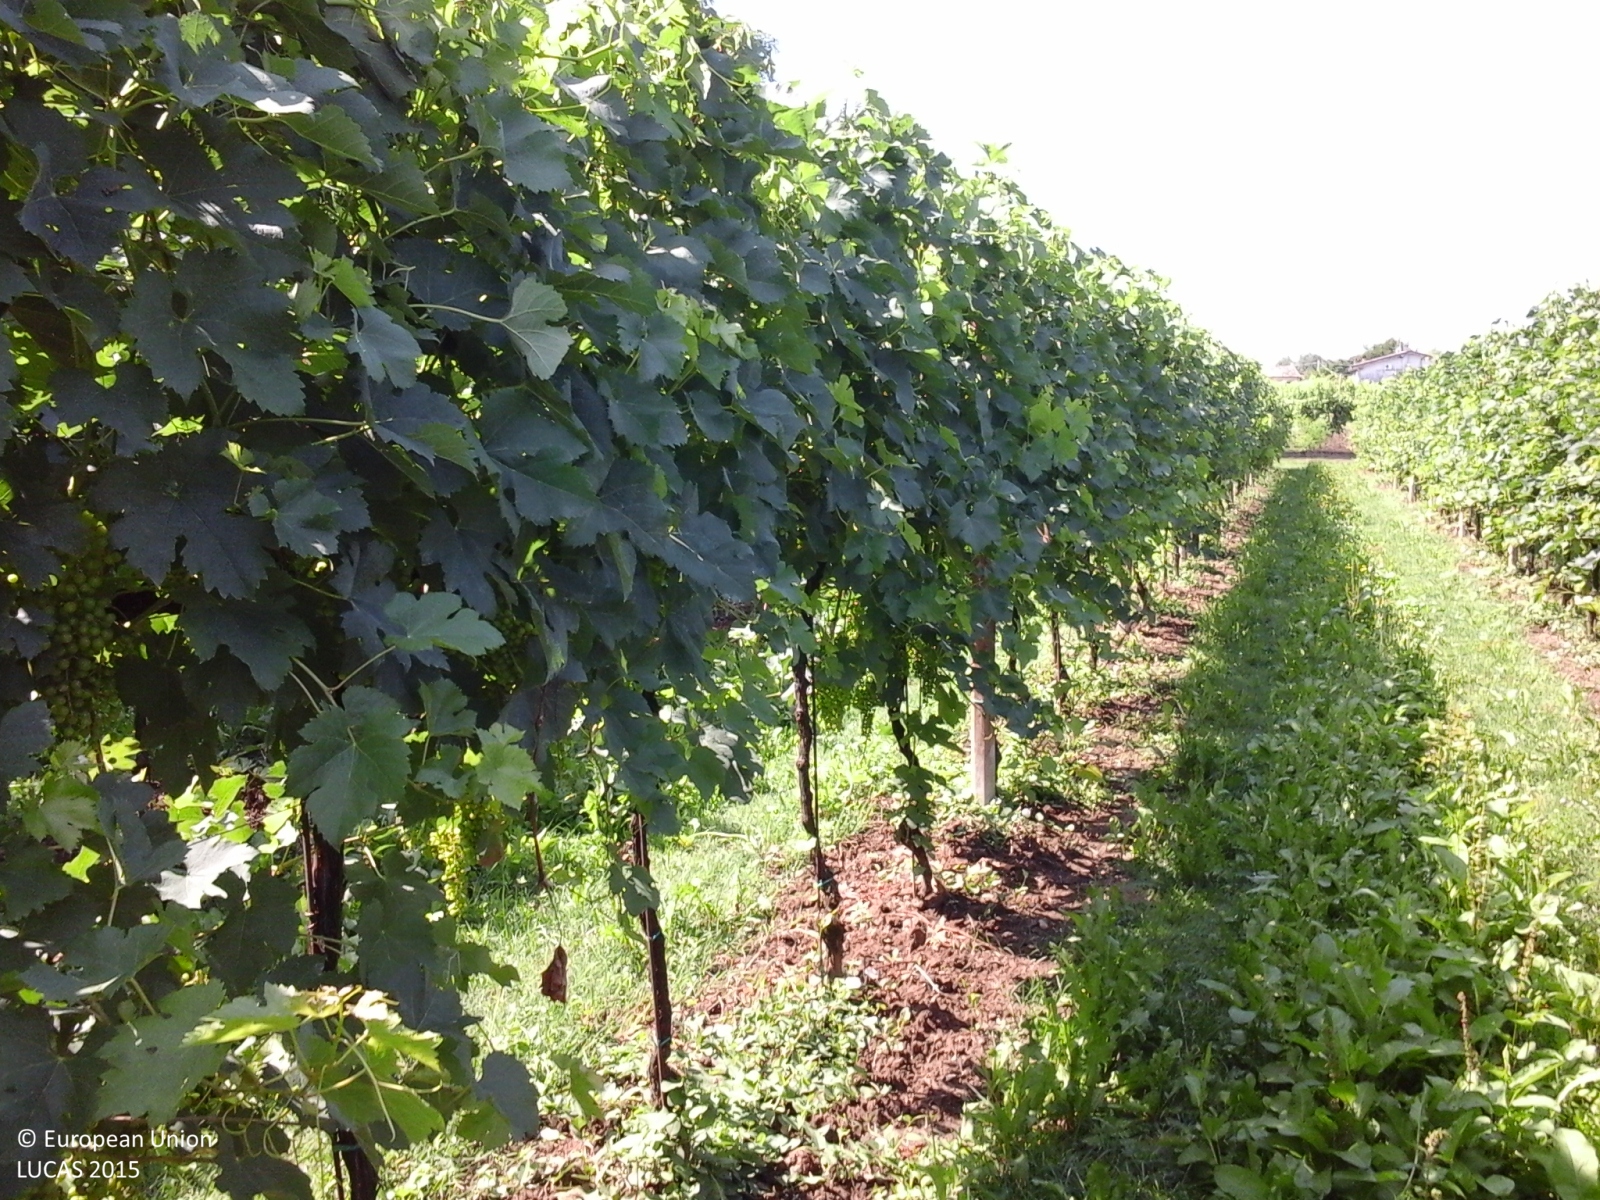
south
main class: Cropland
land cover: Vineyards
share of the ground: 25 - 50 %
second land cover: Grassland without tree/shrub cover
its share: > 75 %
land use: Agriculture (excluding fallow land and kitchen gardens)
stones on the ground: < 10 %
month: June
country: IT
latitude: 45.8928
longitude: 12.3552
